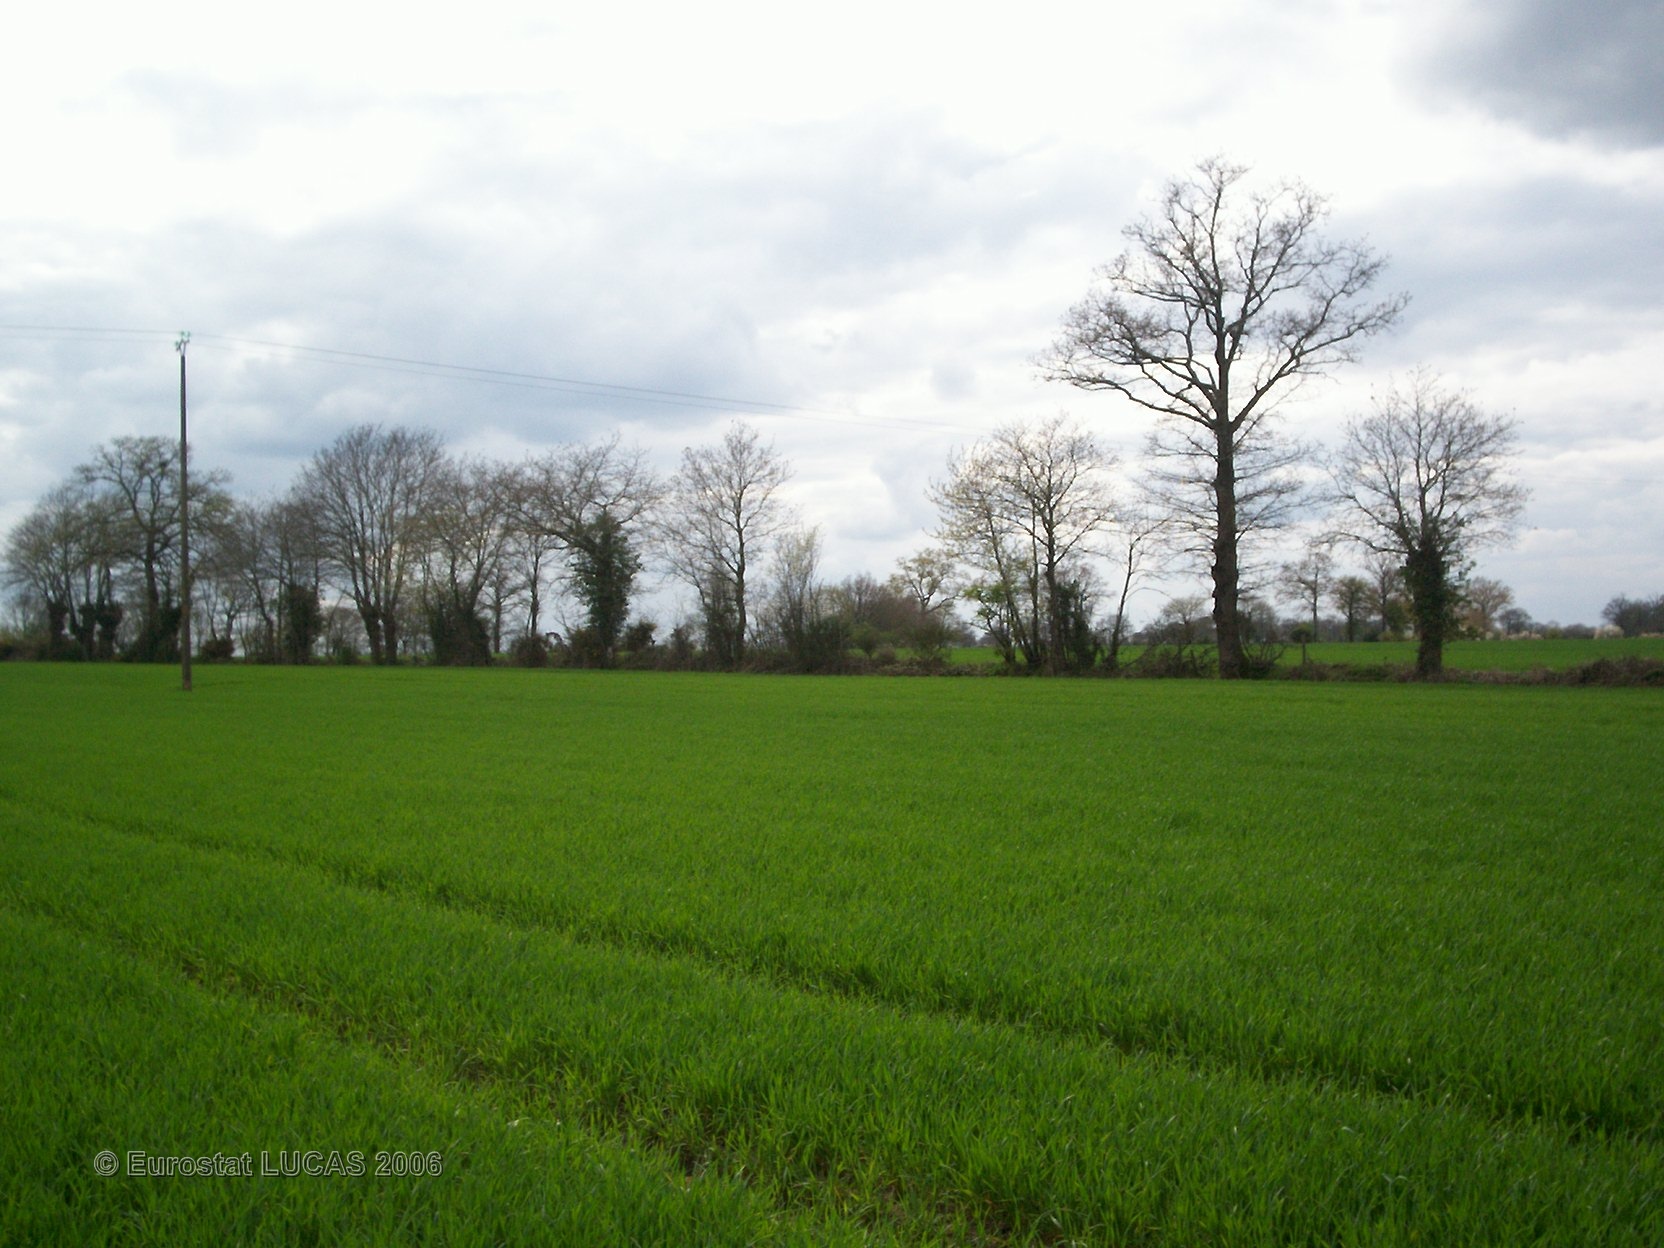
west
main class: Cropland
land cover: Common wheat
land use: Agriculture (excluding fallow land and kitchen gardens)
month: April
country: FR
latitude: 47.9293
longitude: -0.5941
